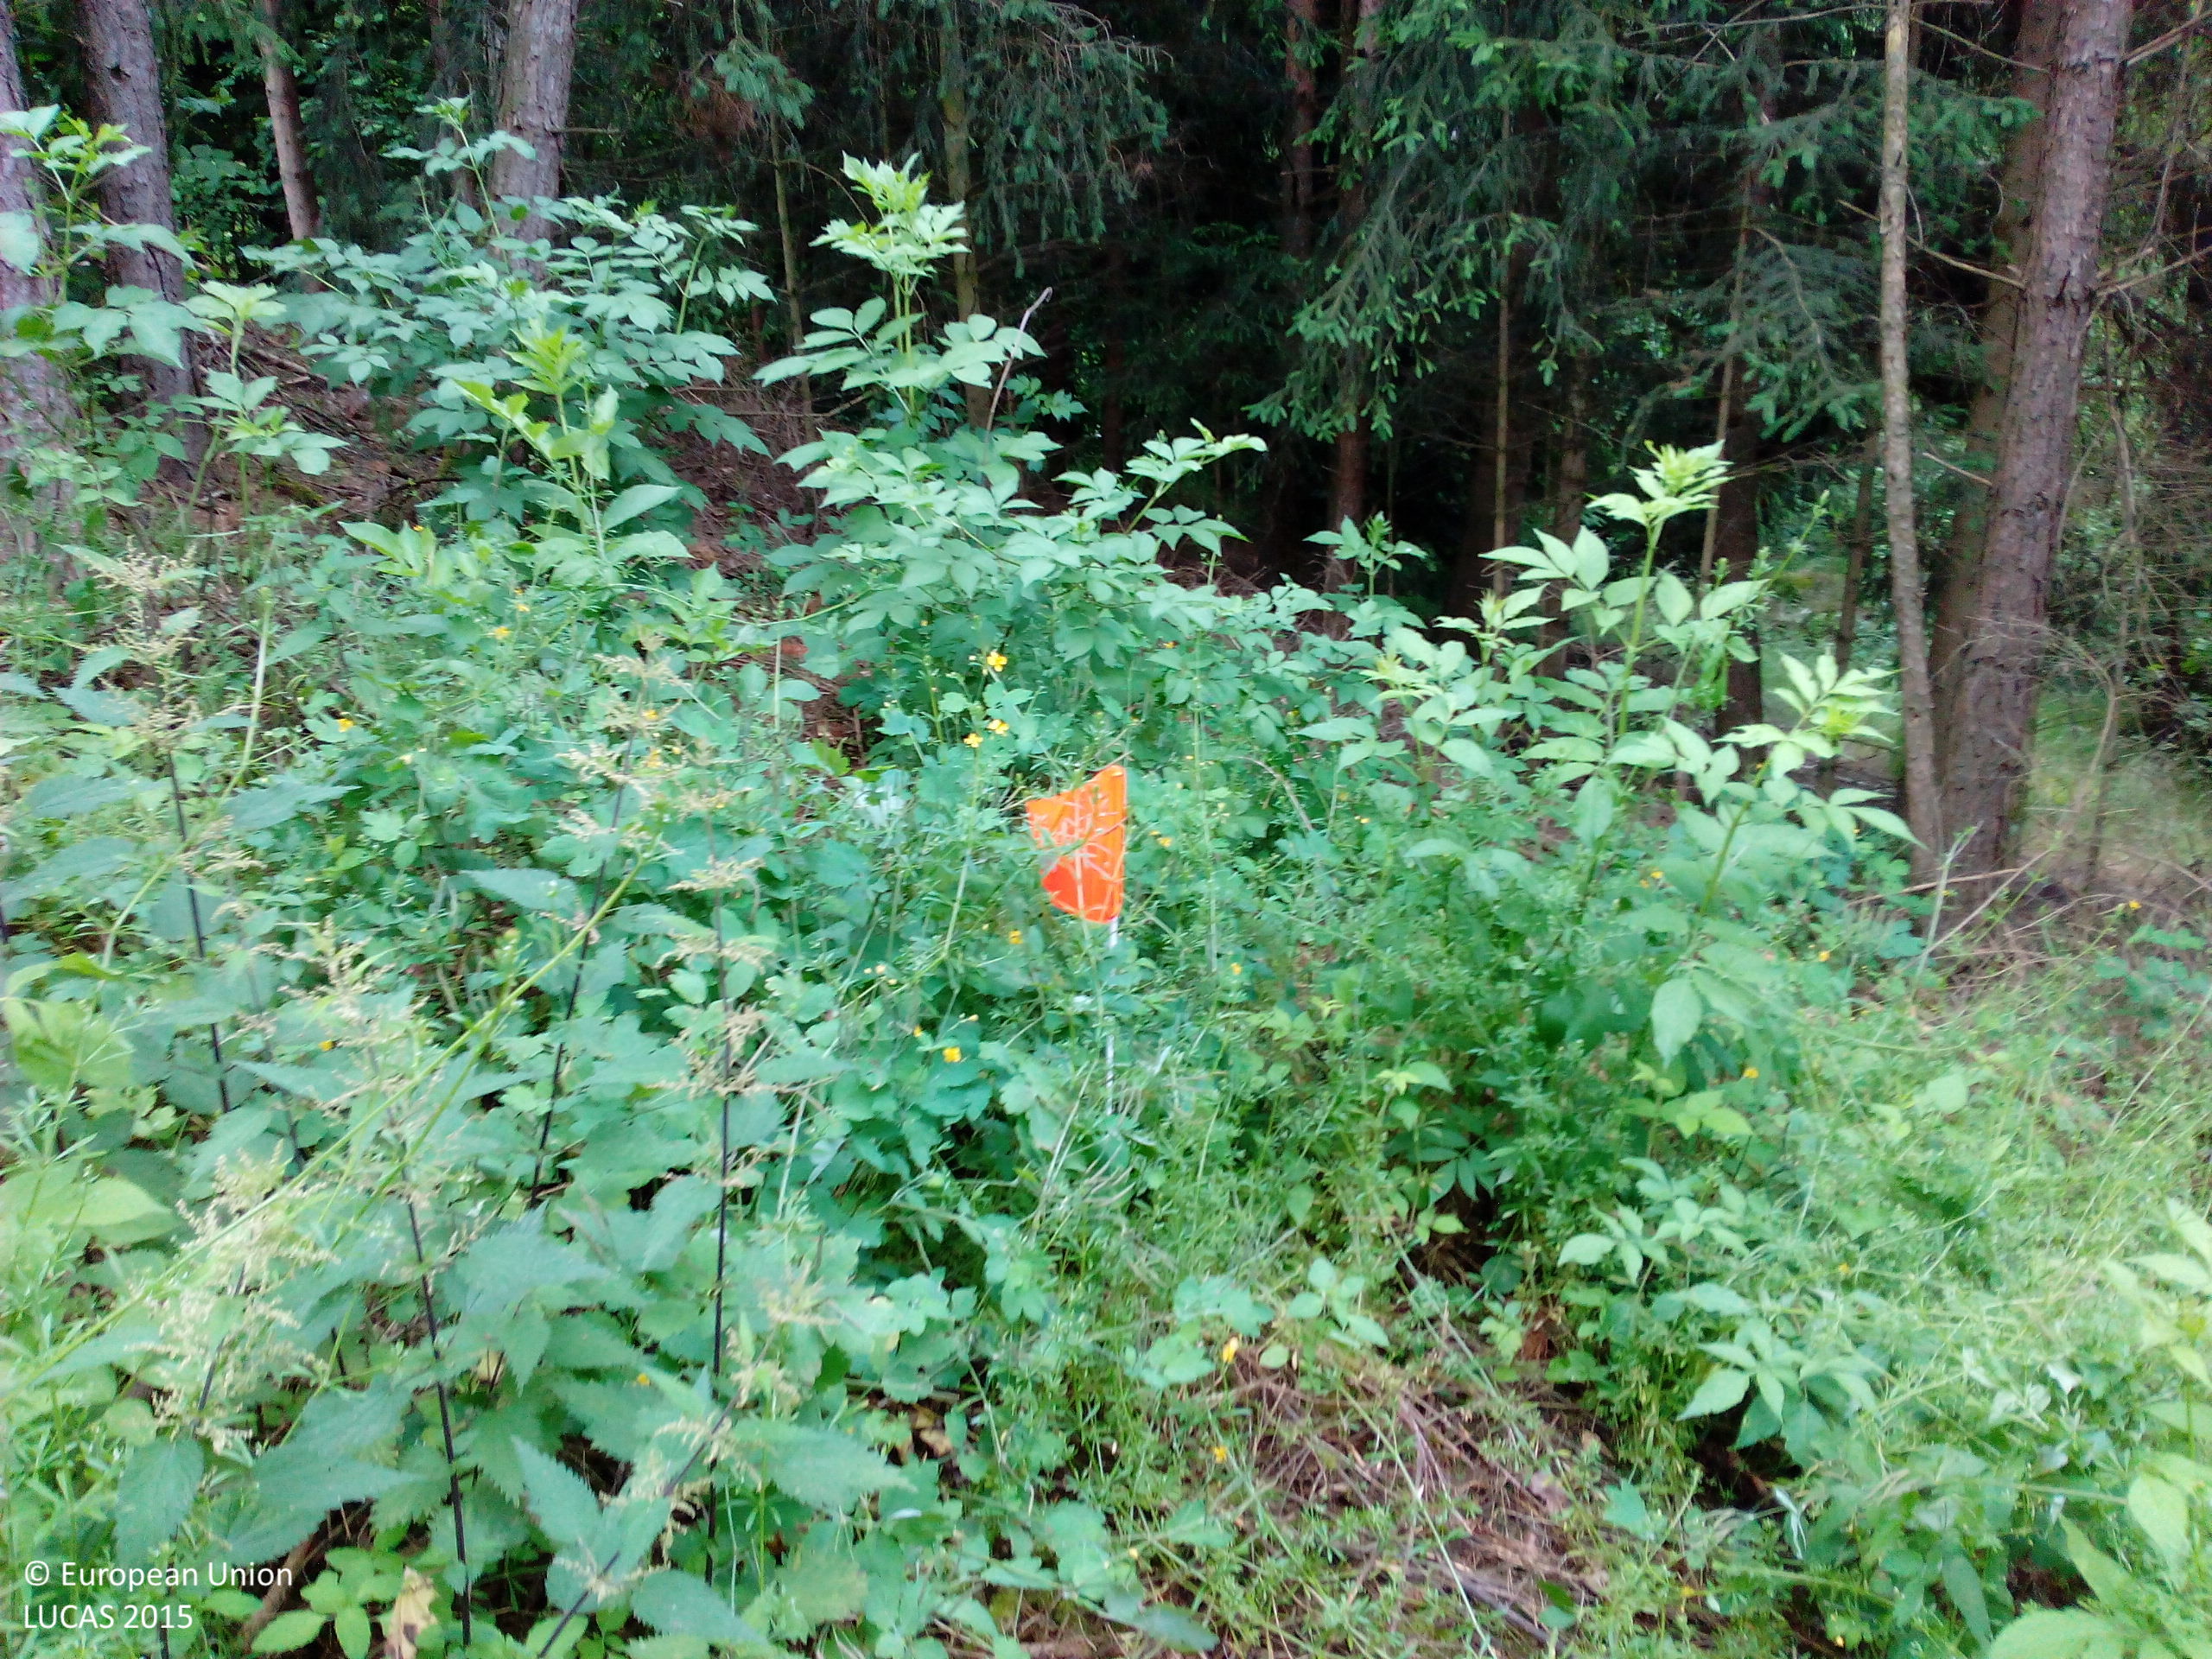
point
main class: Woodland
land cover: Pine dominated coniferous woodland
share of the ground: 25 - 50 %
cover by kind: herbaceous plants 40 %, coniferous forest trees 30 %, lichens and mosses 15 %, unconsolidated bare surface 15 %
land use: Forestry
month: June
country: DE
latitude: 49.0789
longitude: 12.4226
